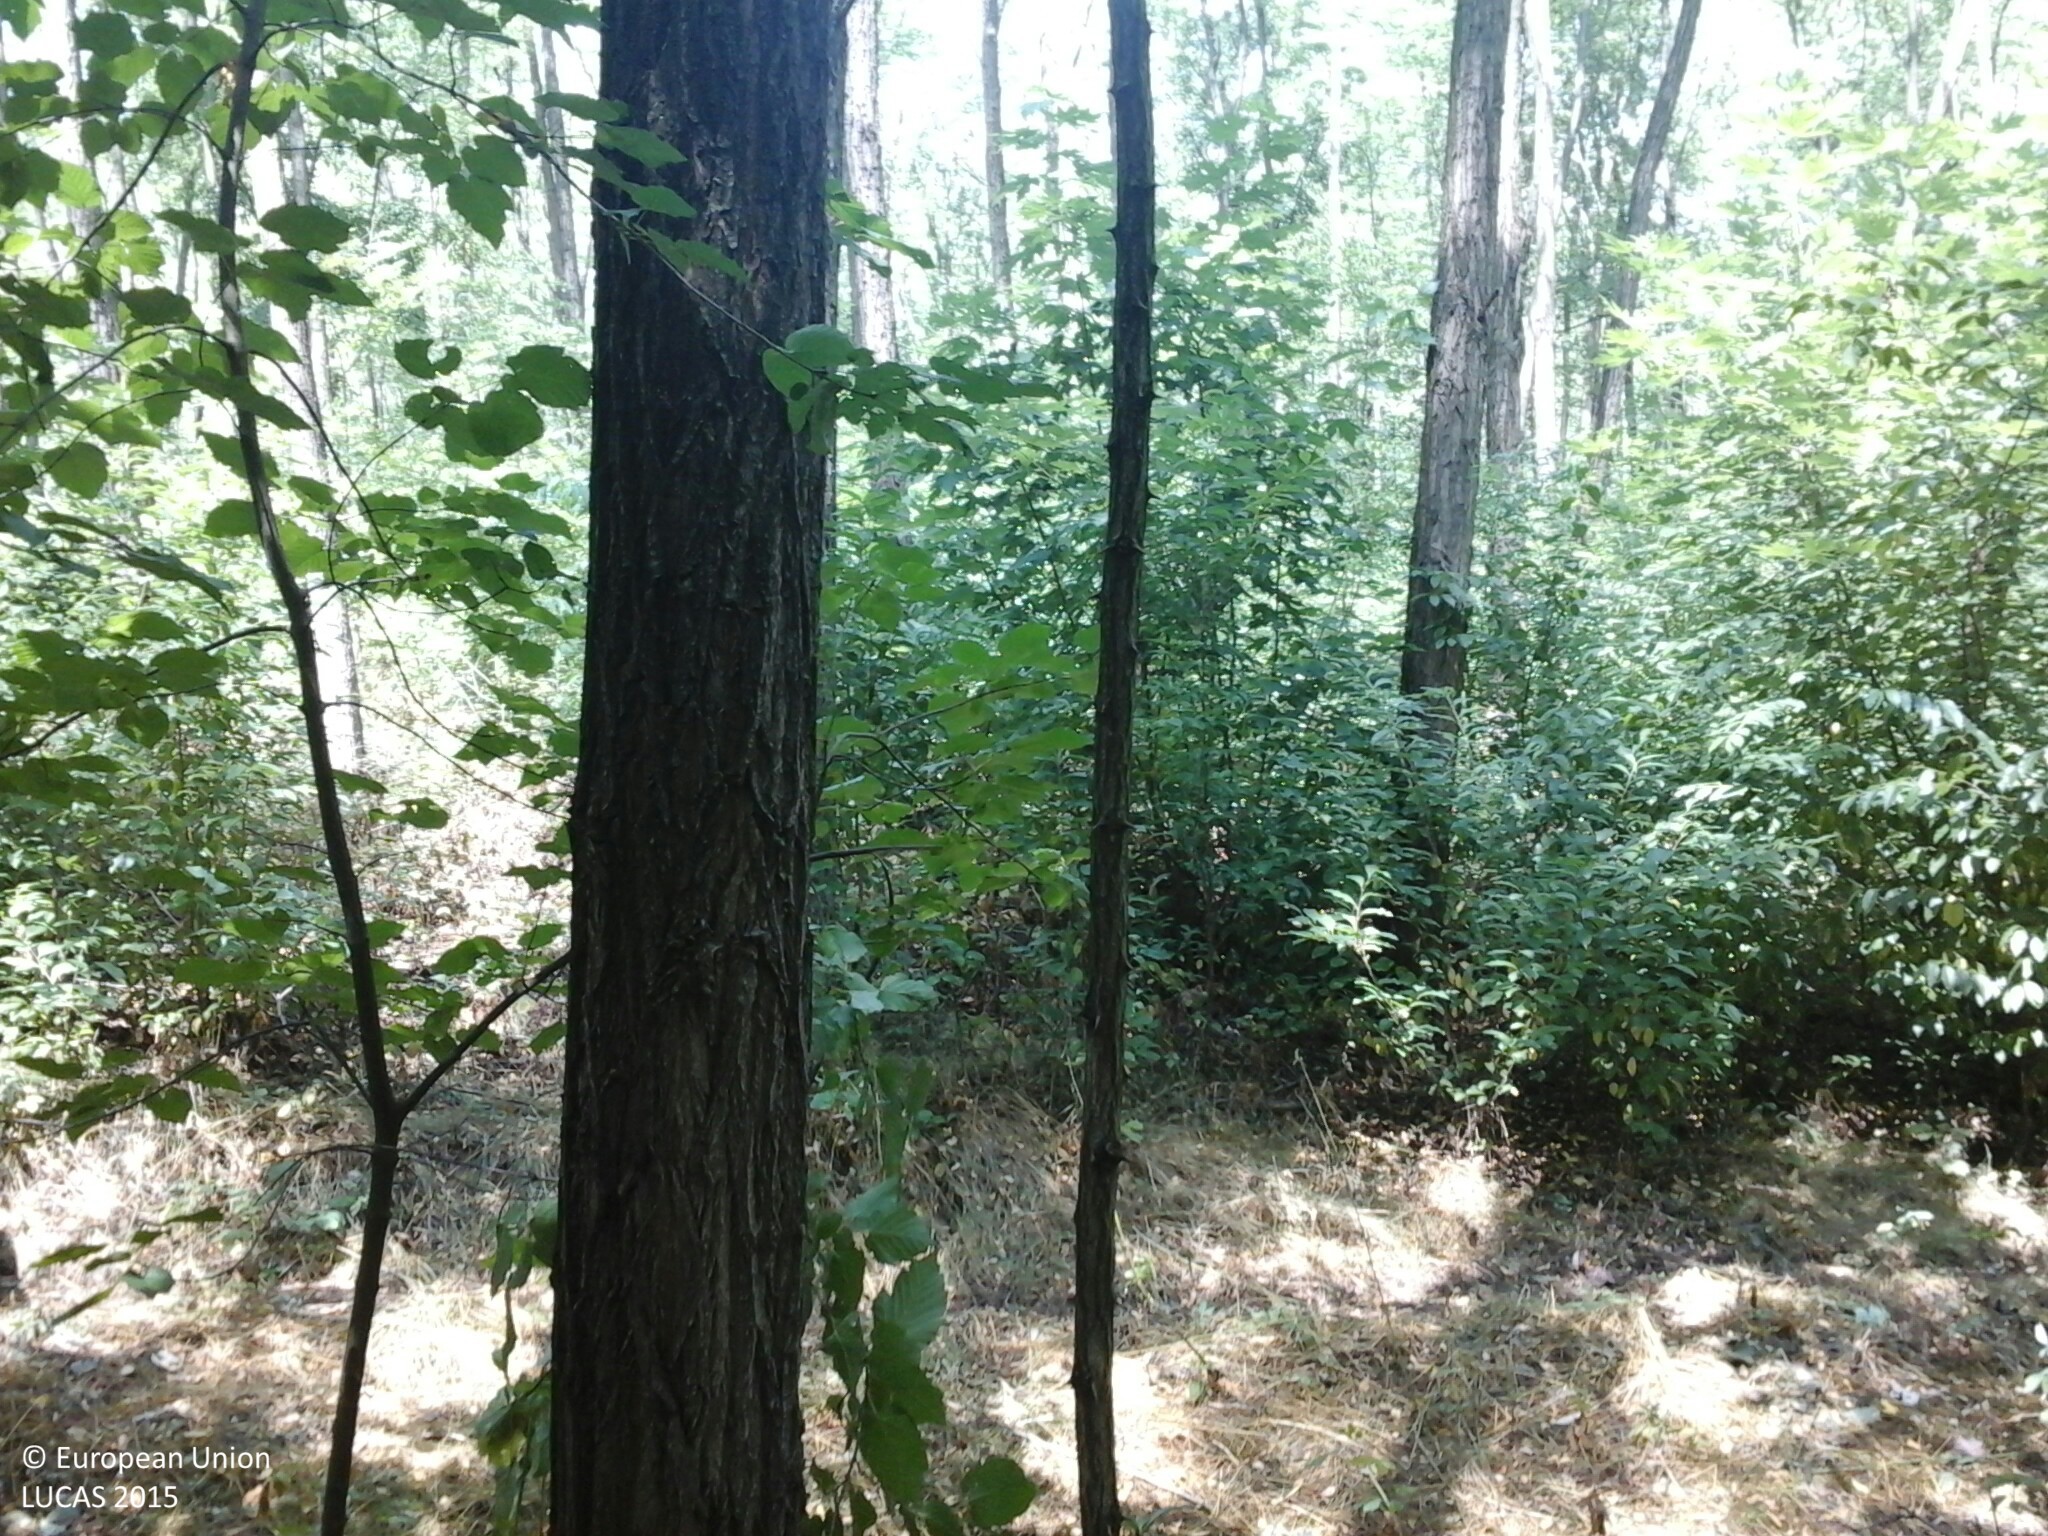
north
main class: Woodland
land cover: Broadleaved woodland
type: mesophytic deciduous forest
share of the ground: > 75 %
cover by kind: broadleaved forest trees 100 %
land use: Forestry
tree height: > 5 m
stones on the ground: < 10 %
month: July
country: HU
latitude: 48.2329
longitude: 22.2135
